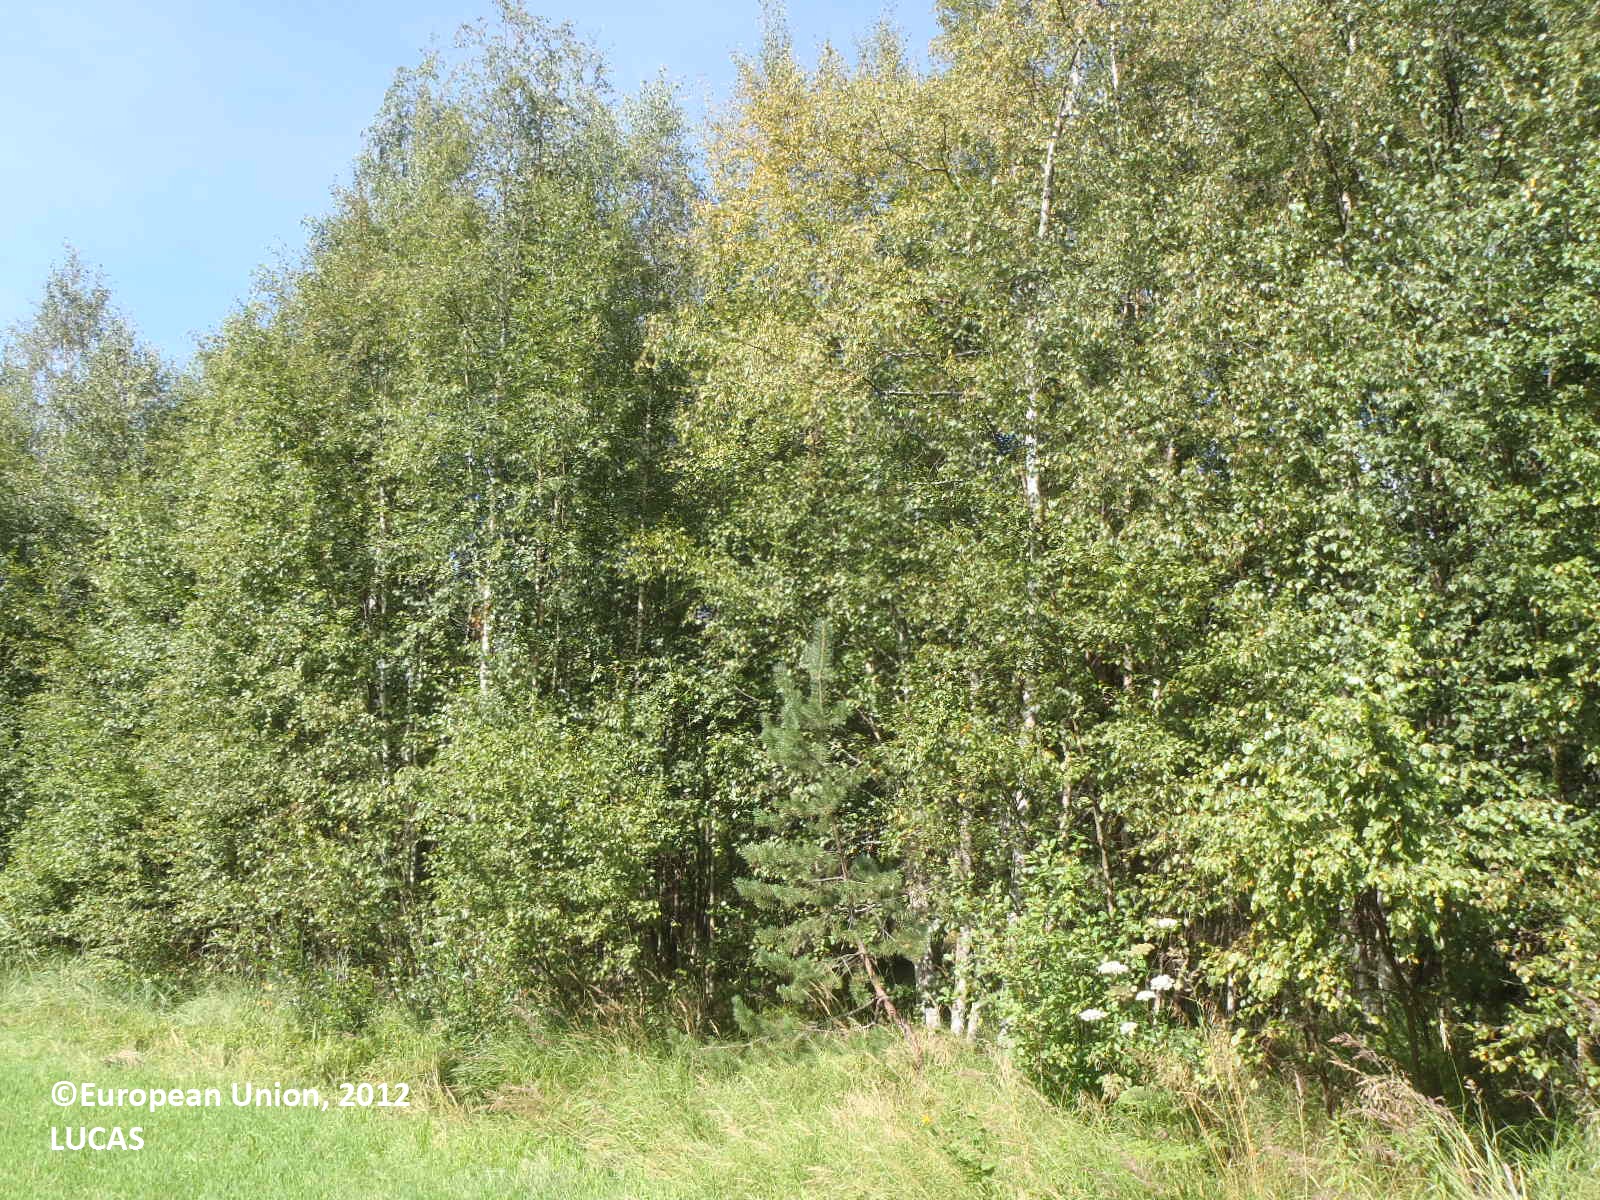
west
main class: Cropland
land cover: Temporary grasslands
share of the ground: > 75 %
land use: Agriculture (excluding fallow land and kitchen gardens)
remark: Harvested field
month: August
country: FI
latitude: 60.3953
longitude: 22.4279
